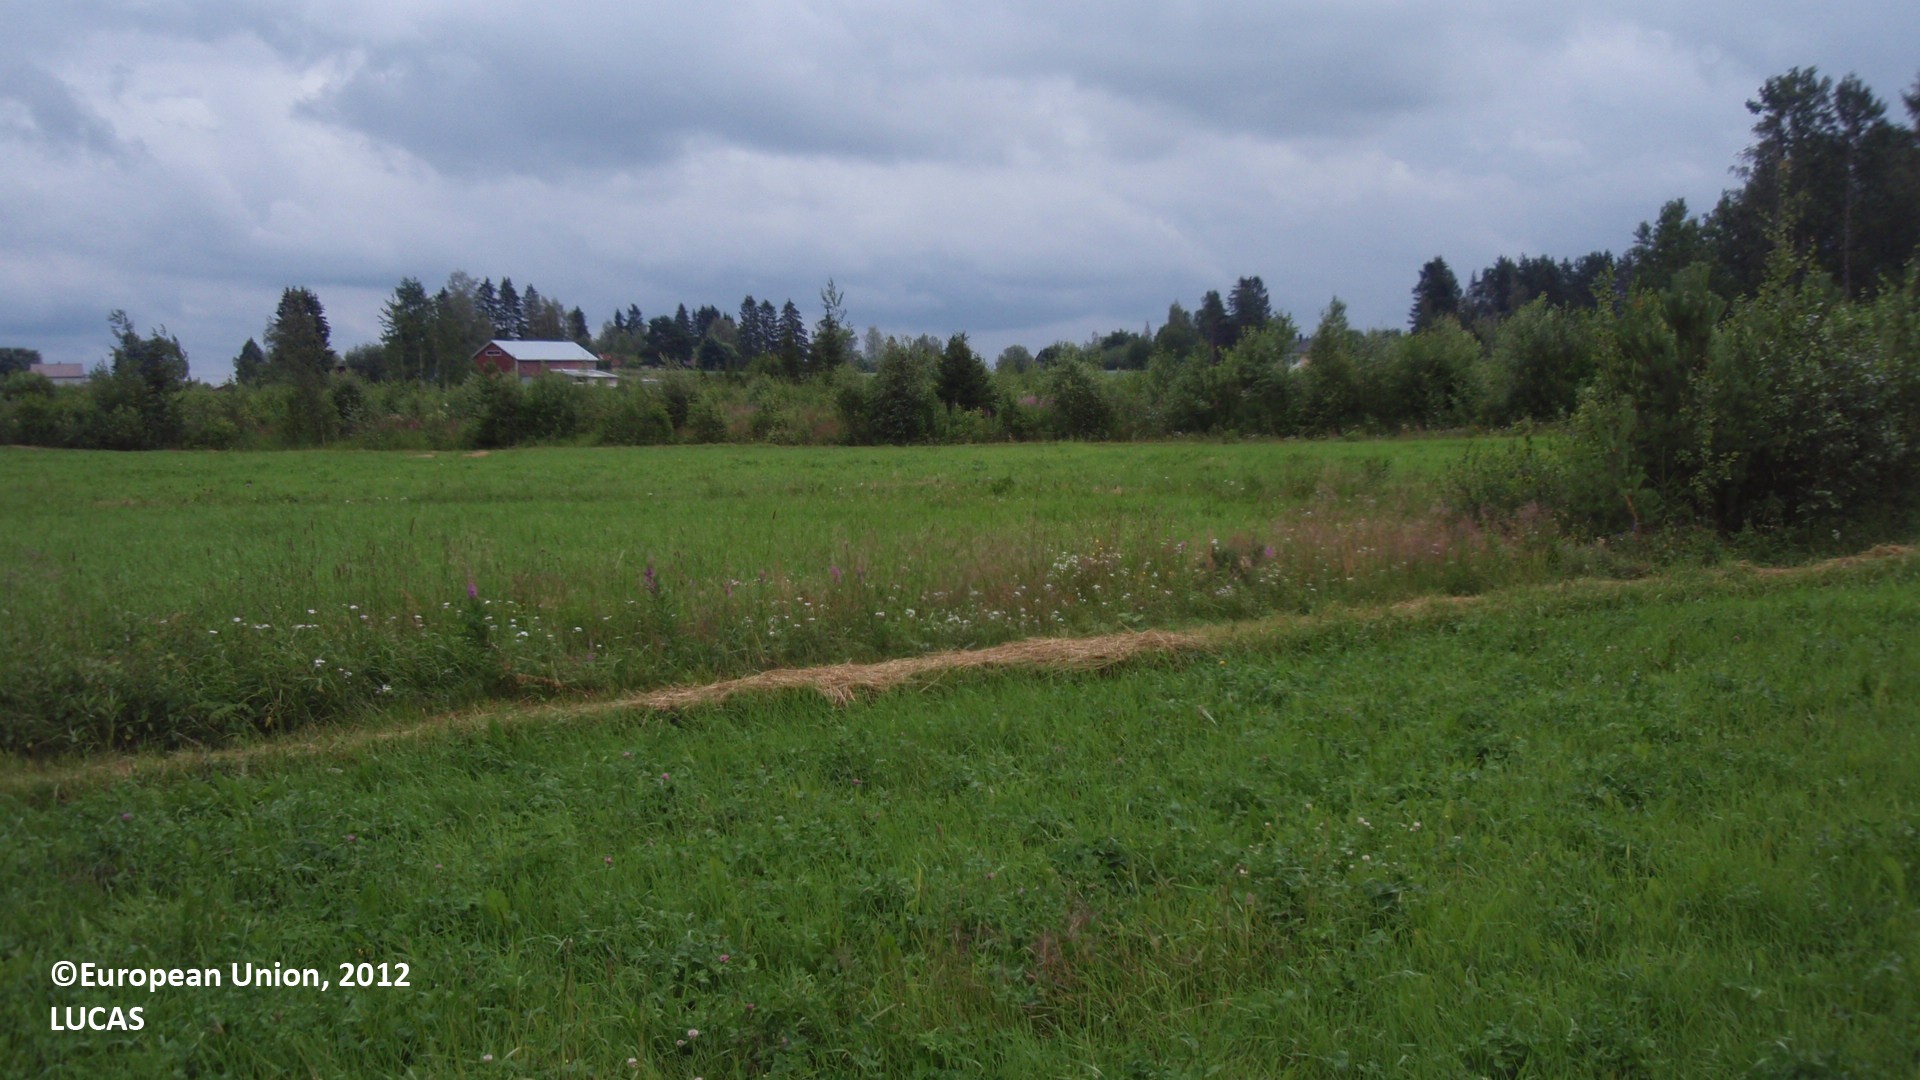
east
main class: Cropland
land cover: Temporary grasslands
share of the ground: > 75 %
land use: Agriculture (excluding fallow land and kitchen gardens)
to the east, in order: Temporary grasslands; Ditches and canals; Temporary grasslands; Ditches and canals; Temporary grasslands; Ditches and canals; Shrubland with sparse tree cover; Ditches and canals; Shrubland with sparse tree cover; Oats; Ditches and canals; Temporary grasslands
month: July
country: FI
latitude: 61.0578
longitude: 28.4999
